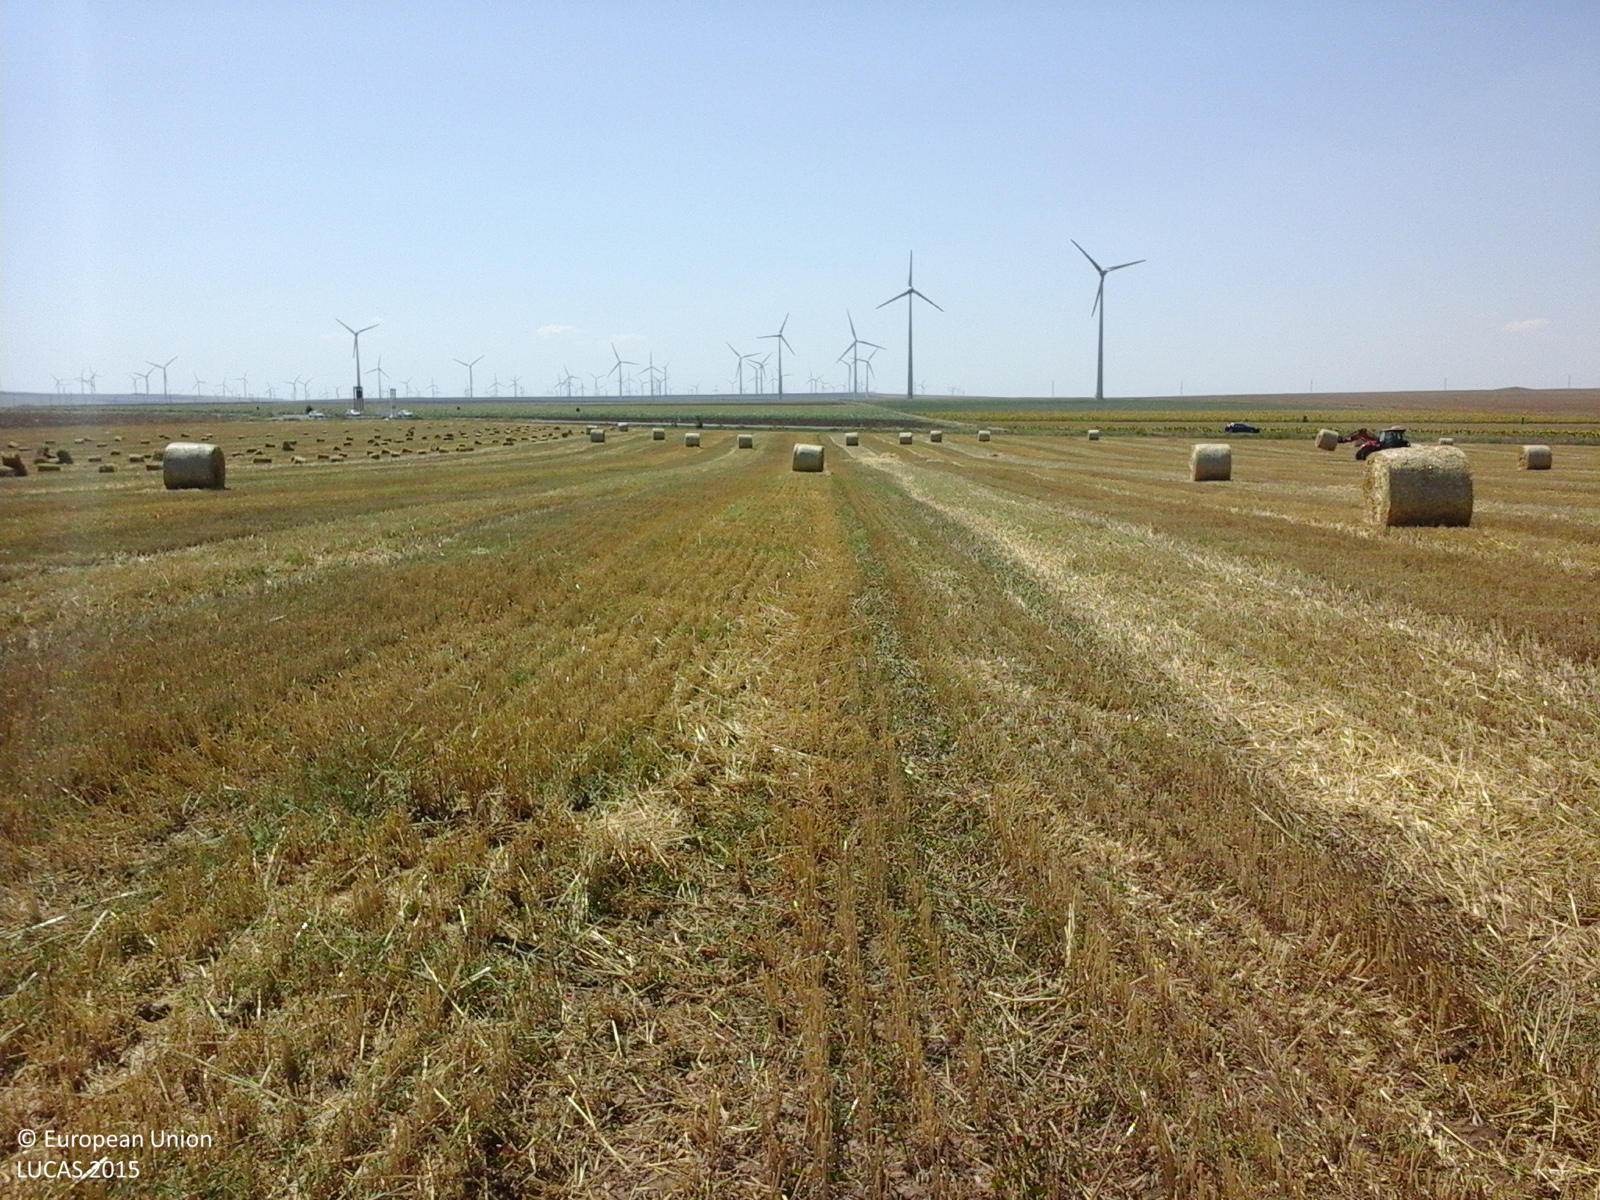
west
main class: Cropland
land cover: Common wheat
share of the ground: > 75 %
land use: Agriculture (excluding fallow land and kitchen gardens)
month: August
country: RO
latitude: 44.6669
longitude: 28.6852
